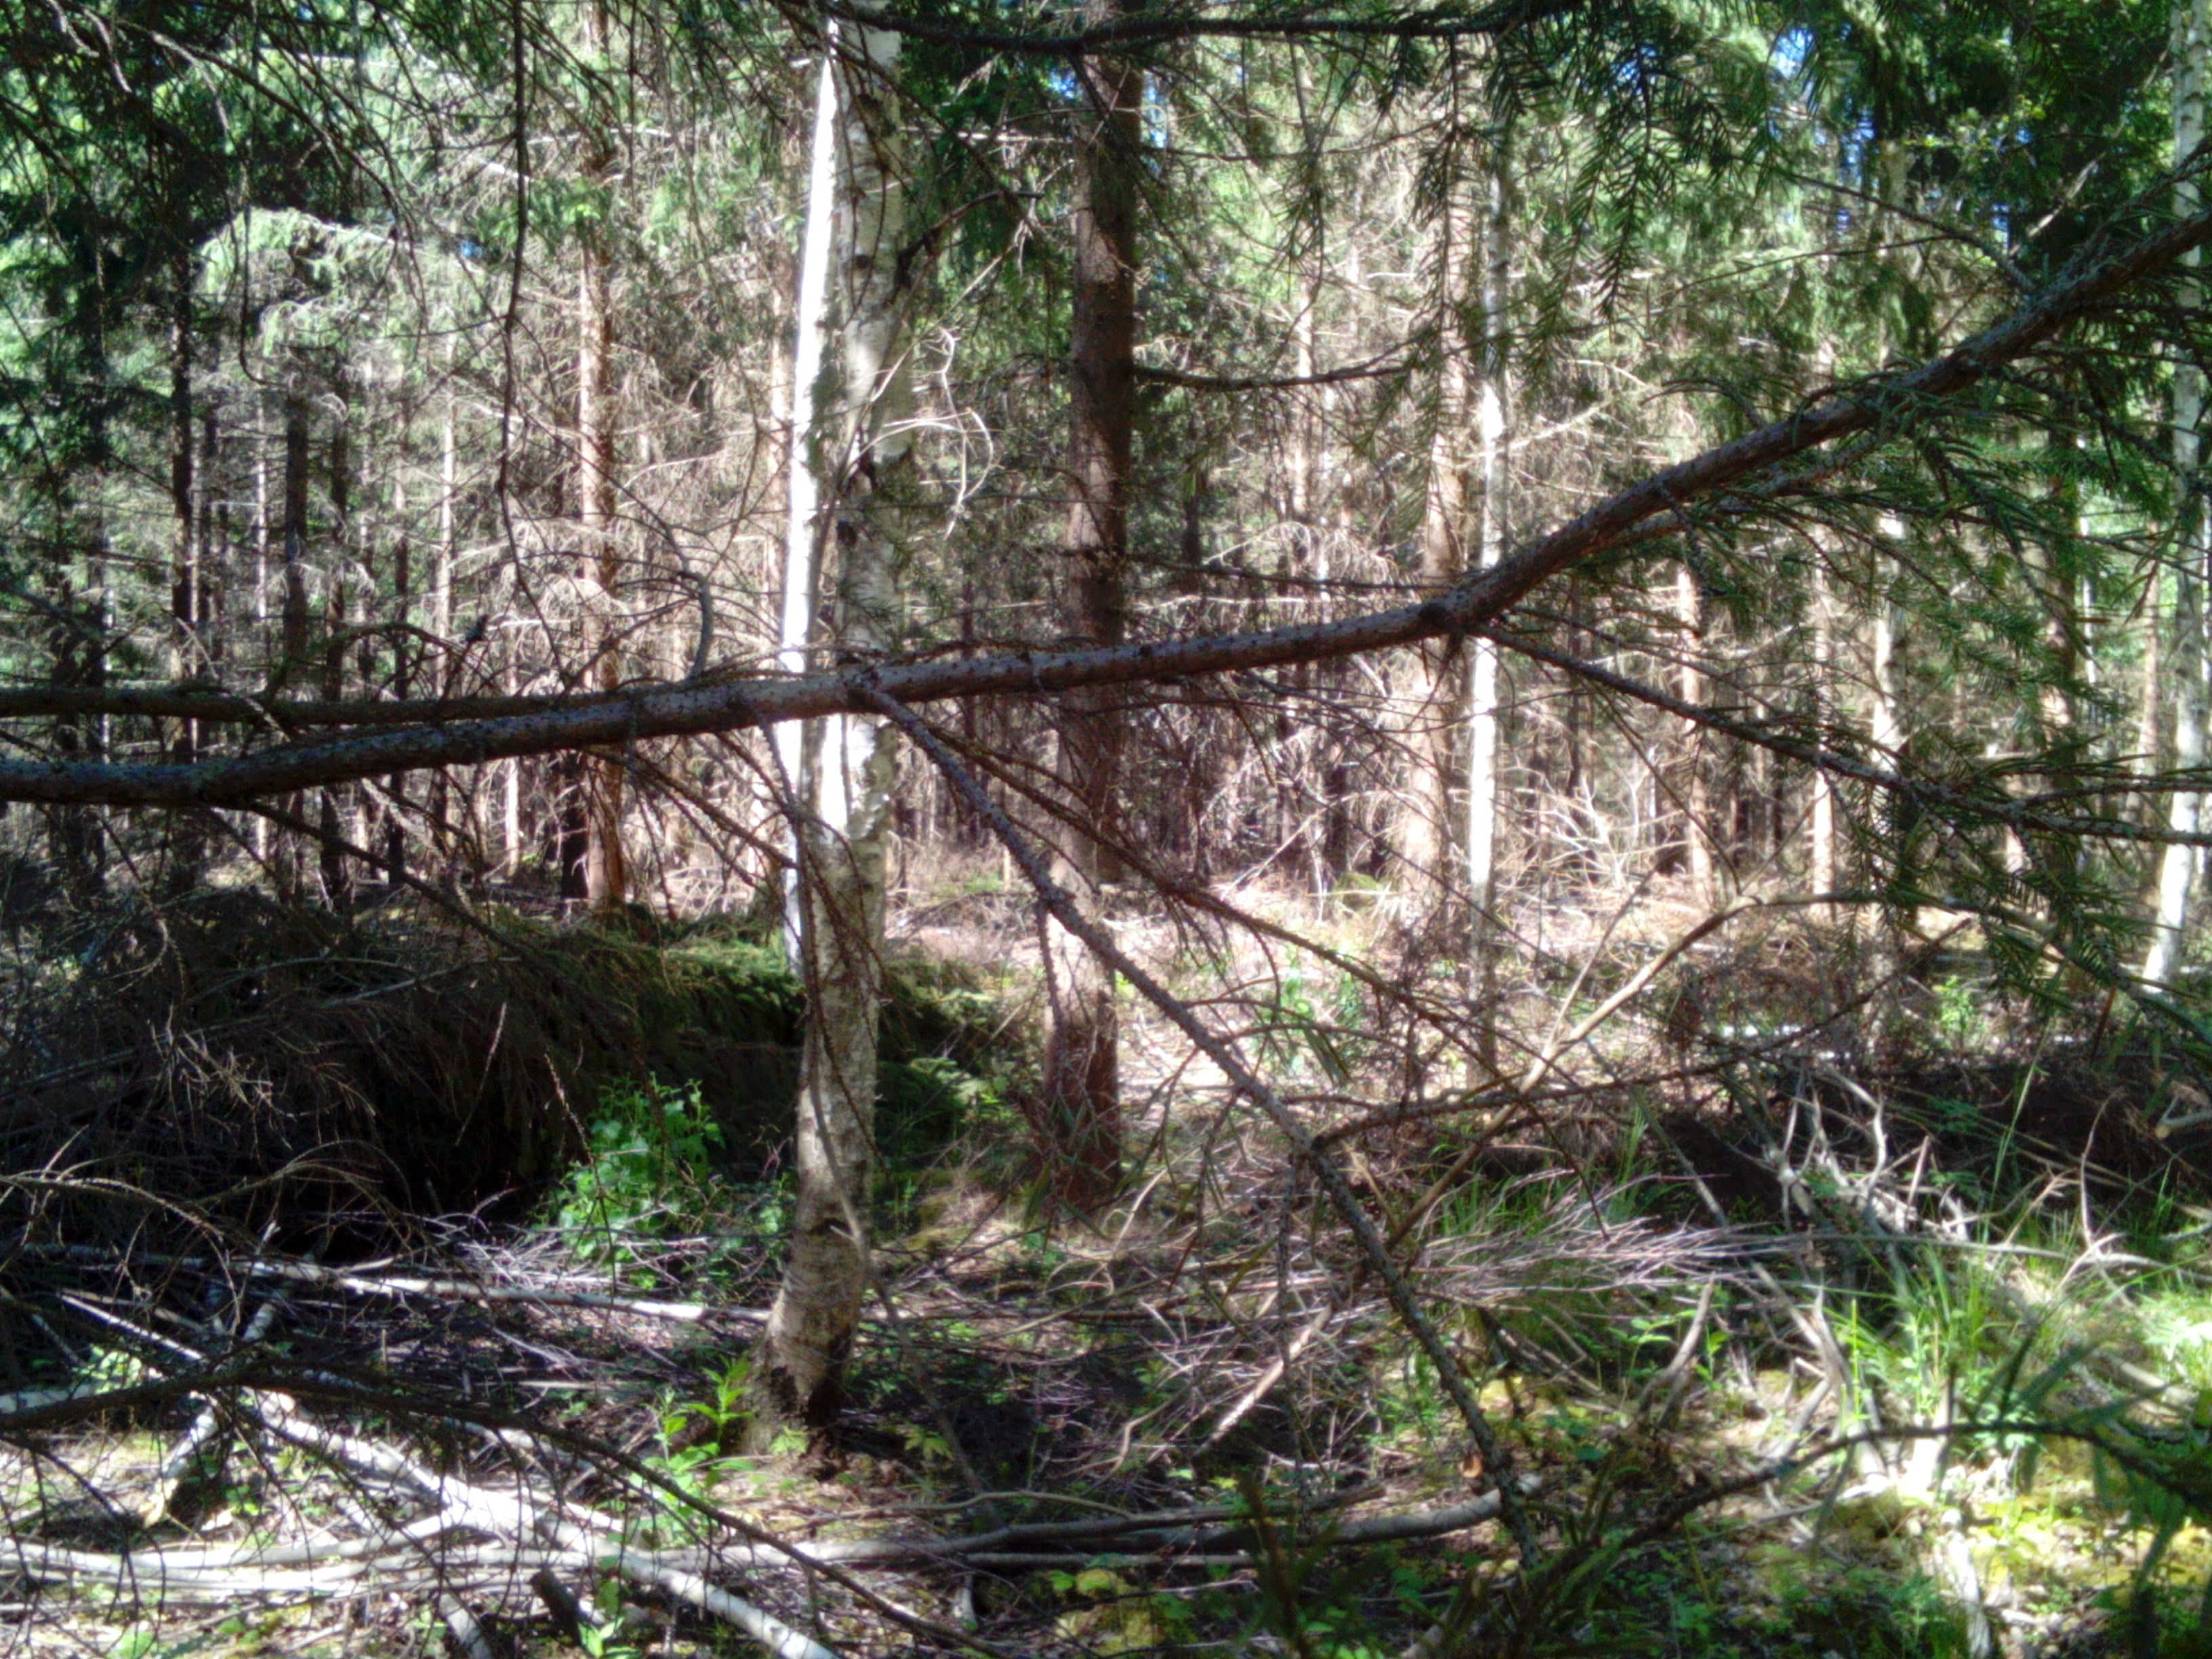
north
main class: Woodland
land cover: Spruce dominated mixed woodland
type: hemiboreal forest and nemoral coniferous forest and mixed broadleaved-coniferous forest
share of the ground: > 75 %
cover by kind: coniferous forest trees 50 %, broadleaved forest trees 35 %, herbaceous plants 5 %, lichens and mosses 5 %, unconsolidated bare surface 5 %
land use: Forestry
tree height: > 5 m
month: July
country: LV
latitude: 56.5586
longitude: 22.1072
